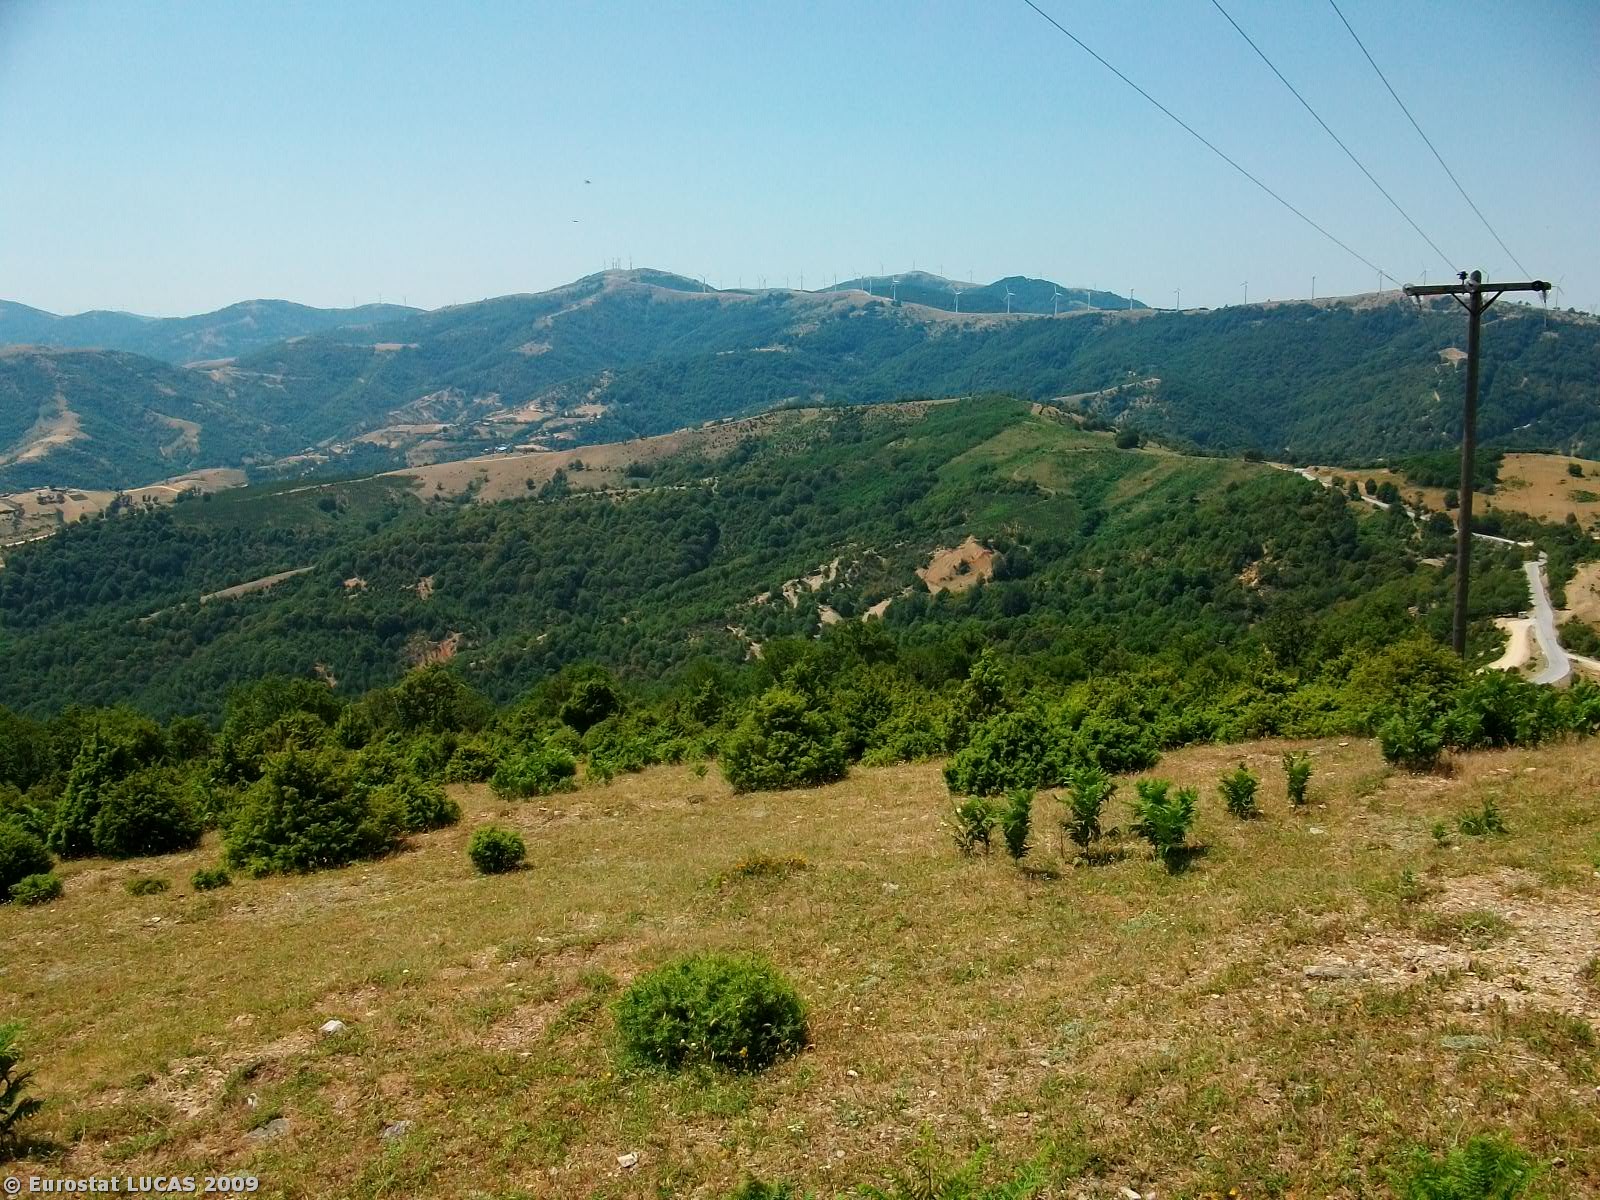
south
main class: Shrubland
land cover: Shrubland without tree cover
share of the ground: > 75 %
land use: Agriculture (excluding fallow land and kitchen gardens)
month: June
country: GR
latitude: 41.2108
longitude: 25.8636
